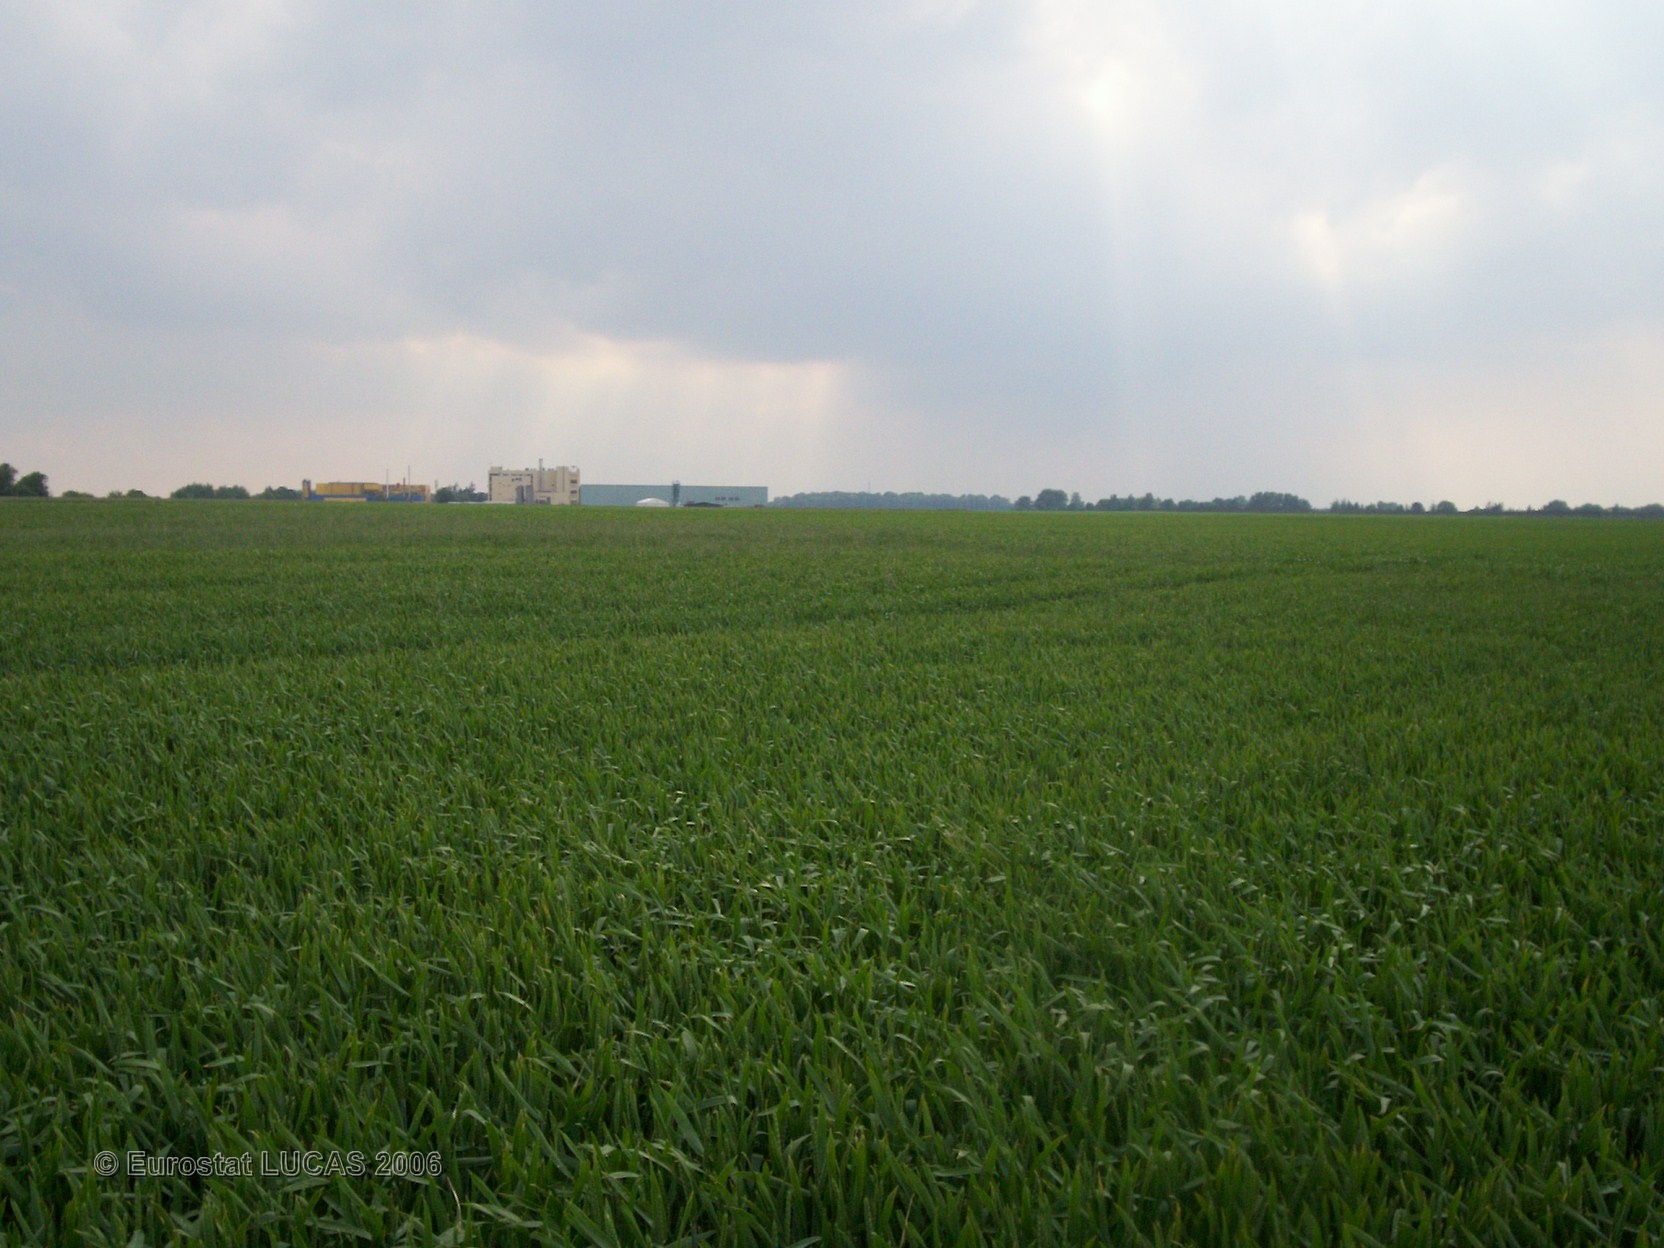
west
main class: Cropland
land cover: Common wheat
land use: Agriculture (excluding fallow land and kitchen gardens)
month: June
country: FR
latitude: 49.6568
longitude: 2.6329
